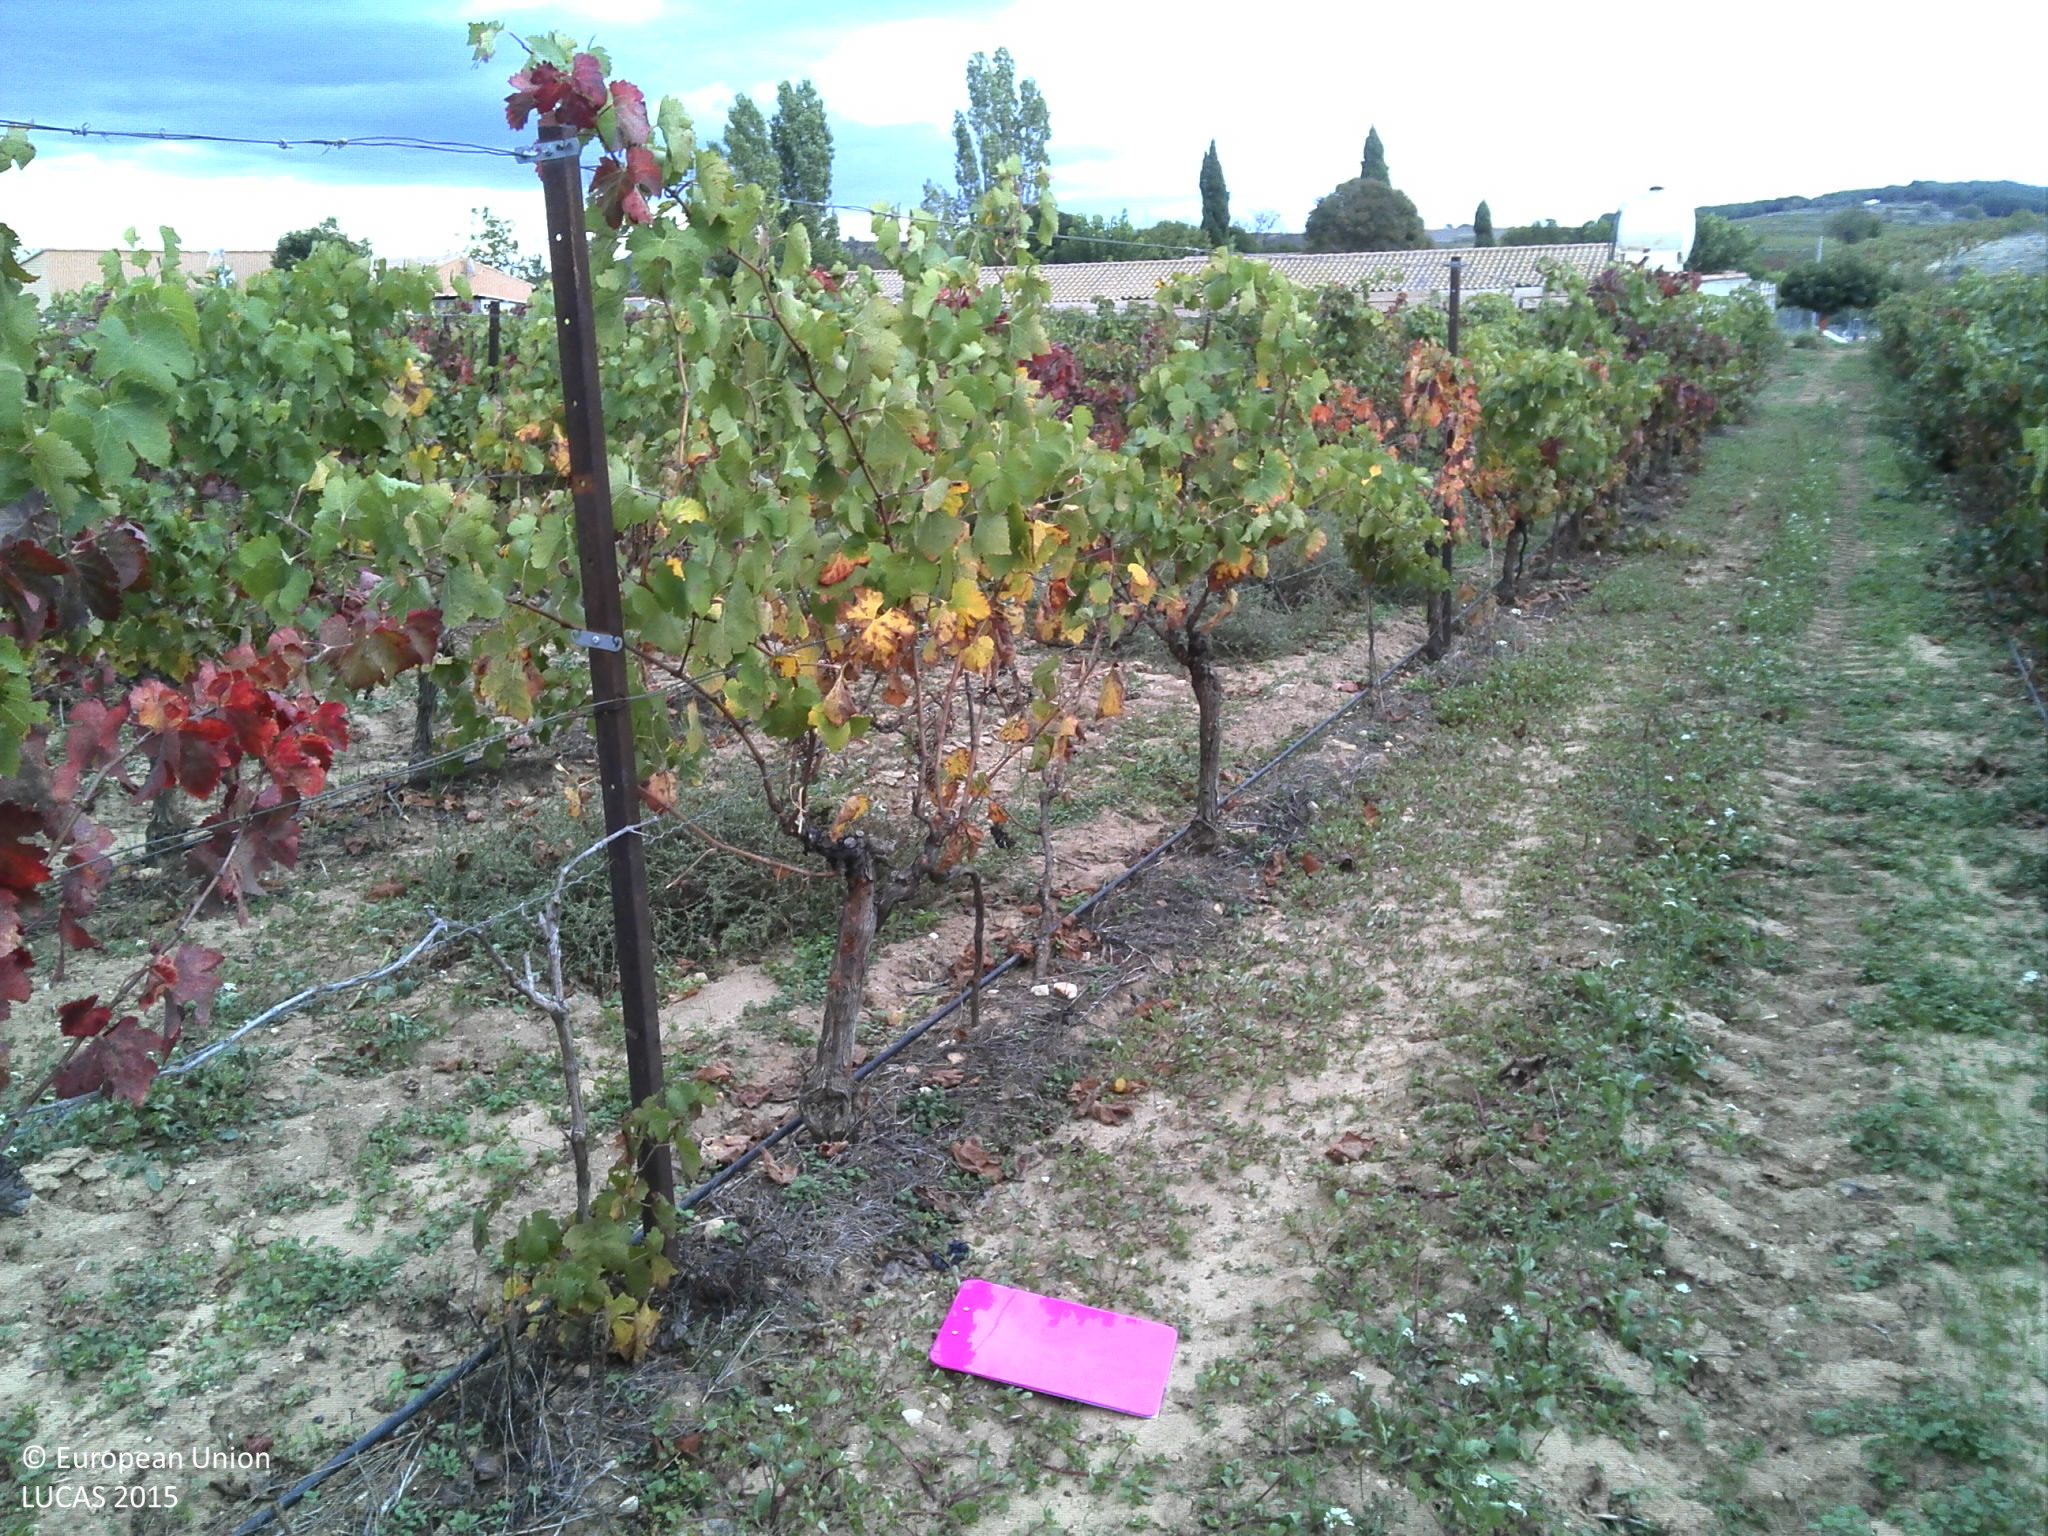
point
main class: Cropland
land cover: Vineyards
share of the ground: 10 - 25 %
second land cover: Spontaneously vegetated surfaces
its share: 50 - 75 %
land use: Agriculture (excluding fallow land and kitchen gardens)
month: October
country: FR
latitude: 43.3629
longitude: 3.1360
